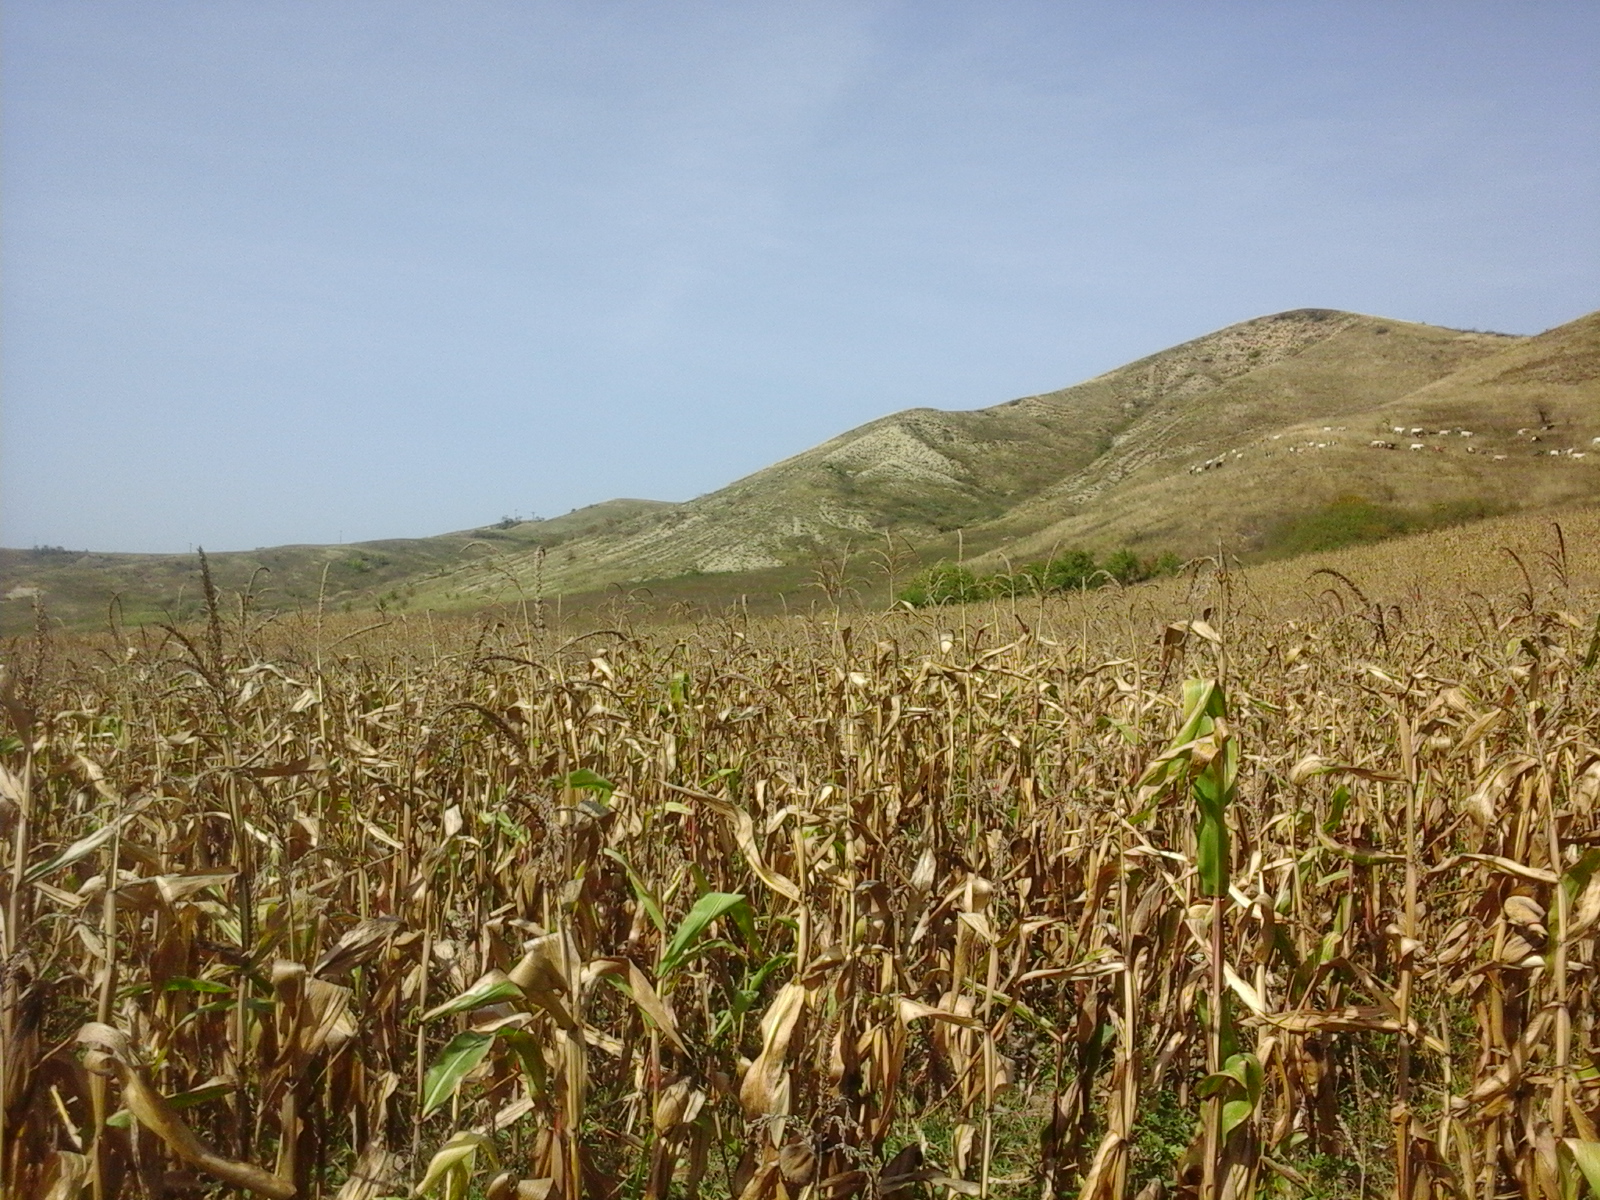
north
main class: Cropland
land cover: Maize
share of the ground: > 75 %
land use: Agriculture (excluding fallow land and kitchen gardens)
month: September
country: RO
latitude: 46.8641
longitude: 23.8904
